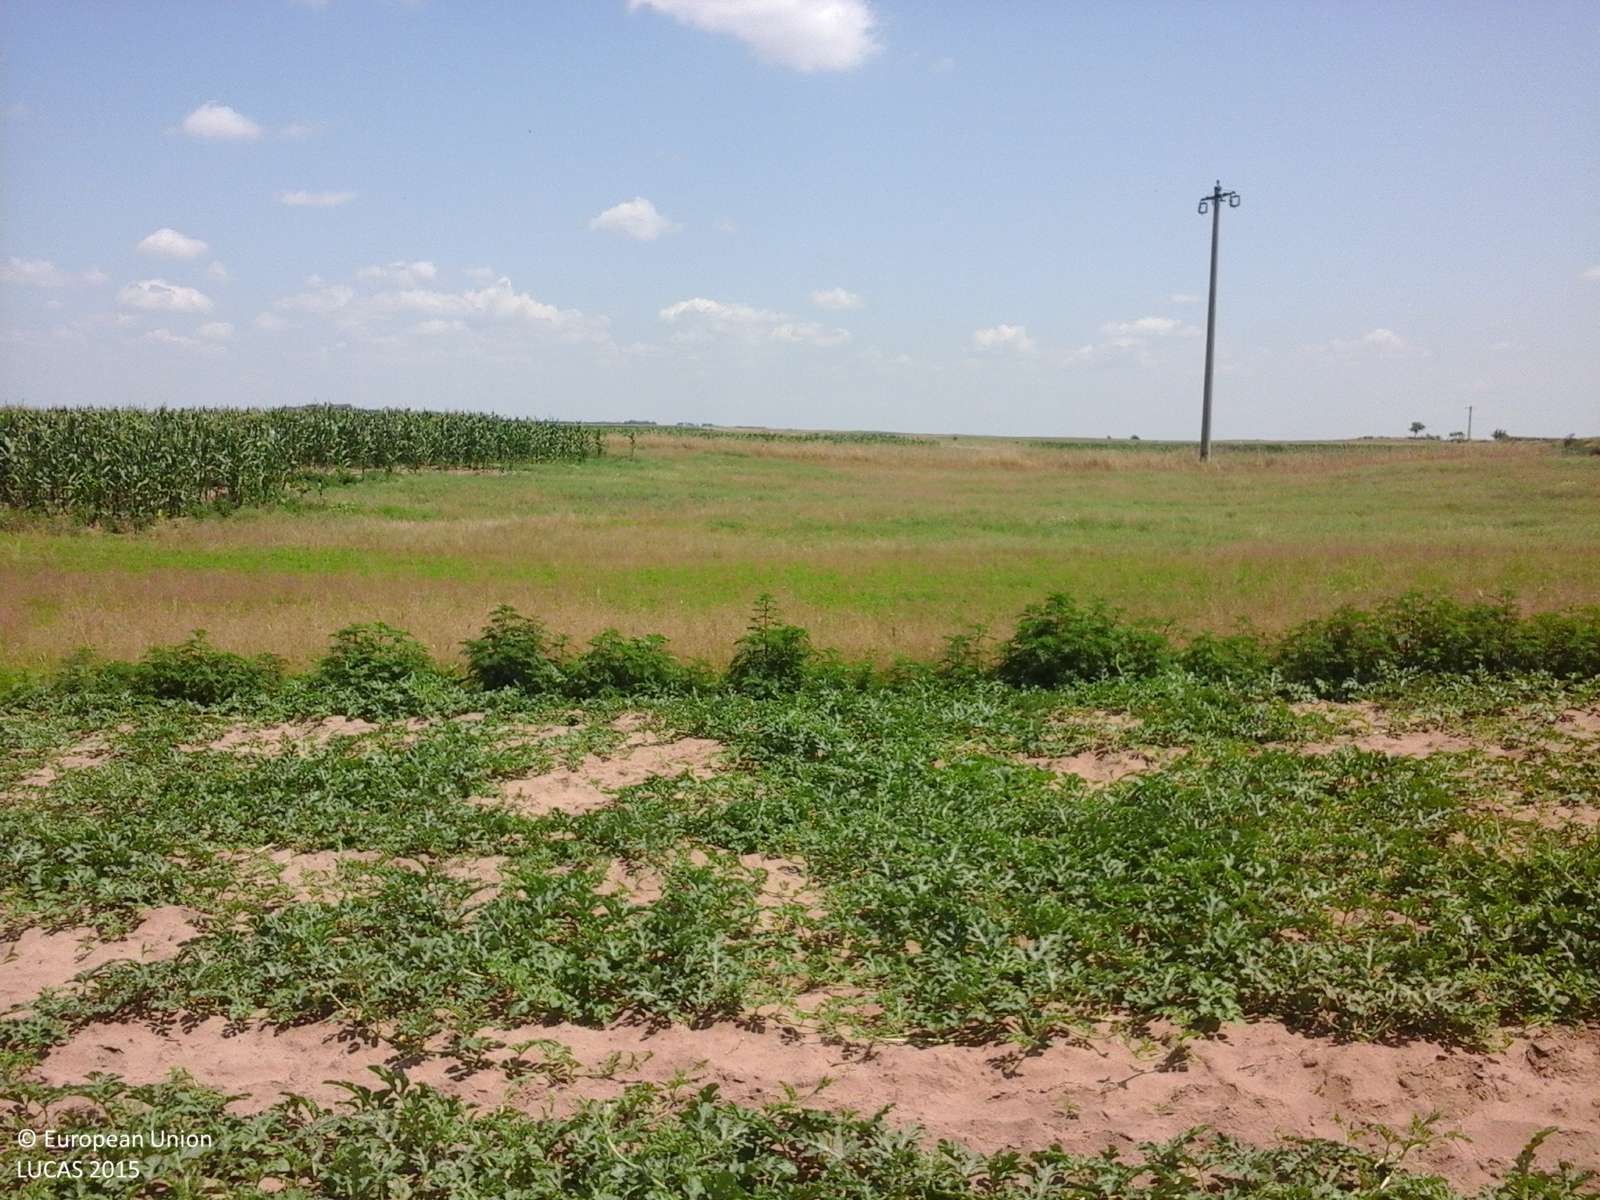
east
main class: Cropland
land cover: Other fresh vegetables
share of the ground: 25 - 50 %
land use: Agriculture (excluding fallow land and kitchen gardens)
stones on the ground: < 10 %
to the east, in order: Other fresh vegetables; Grassland without tree/shrub cover; Tracks; Electric lines; Common wheat; Ditches and canals; Grass margins; Tracks; Grassland without tree/shrub cover; Other bare soil; Grassland without tree/shrub cover; Maize; Common wheat; Grassland without tree/shrub cover
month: July
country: RO
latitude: 44.0121
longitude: 24.0409
